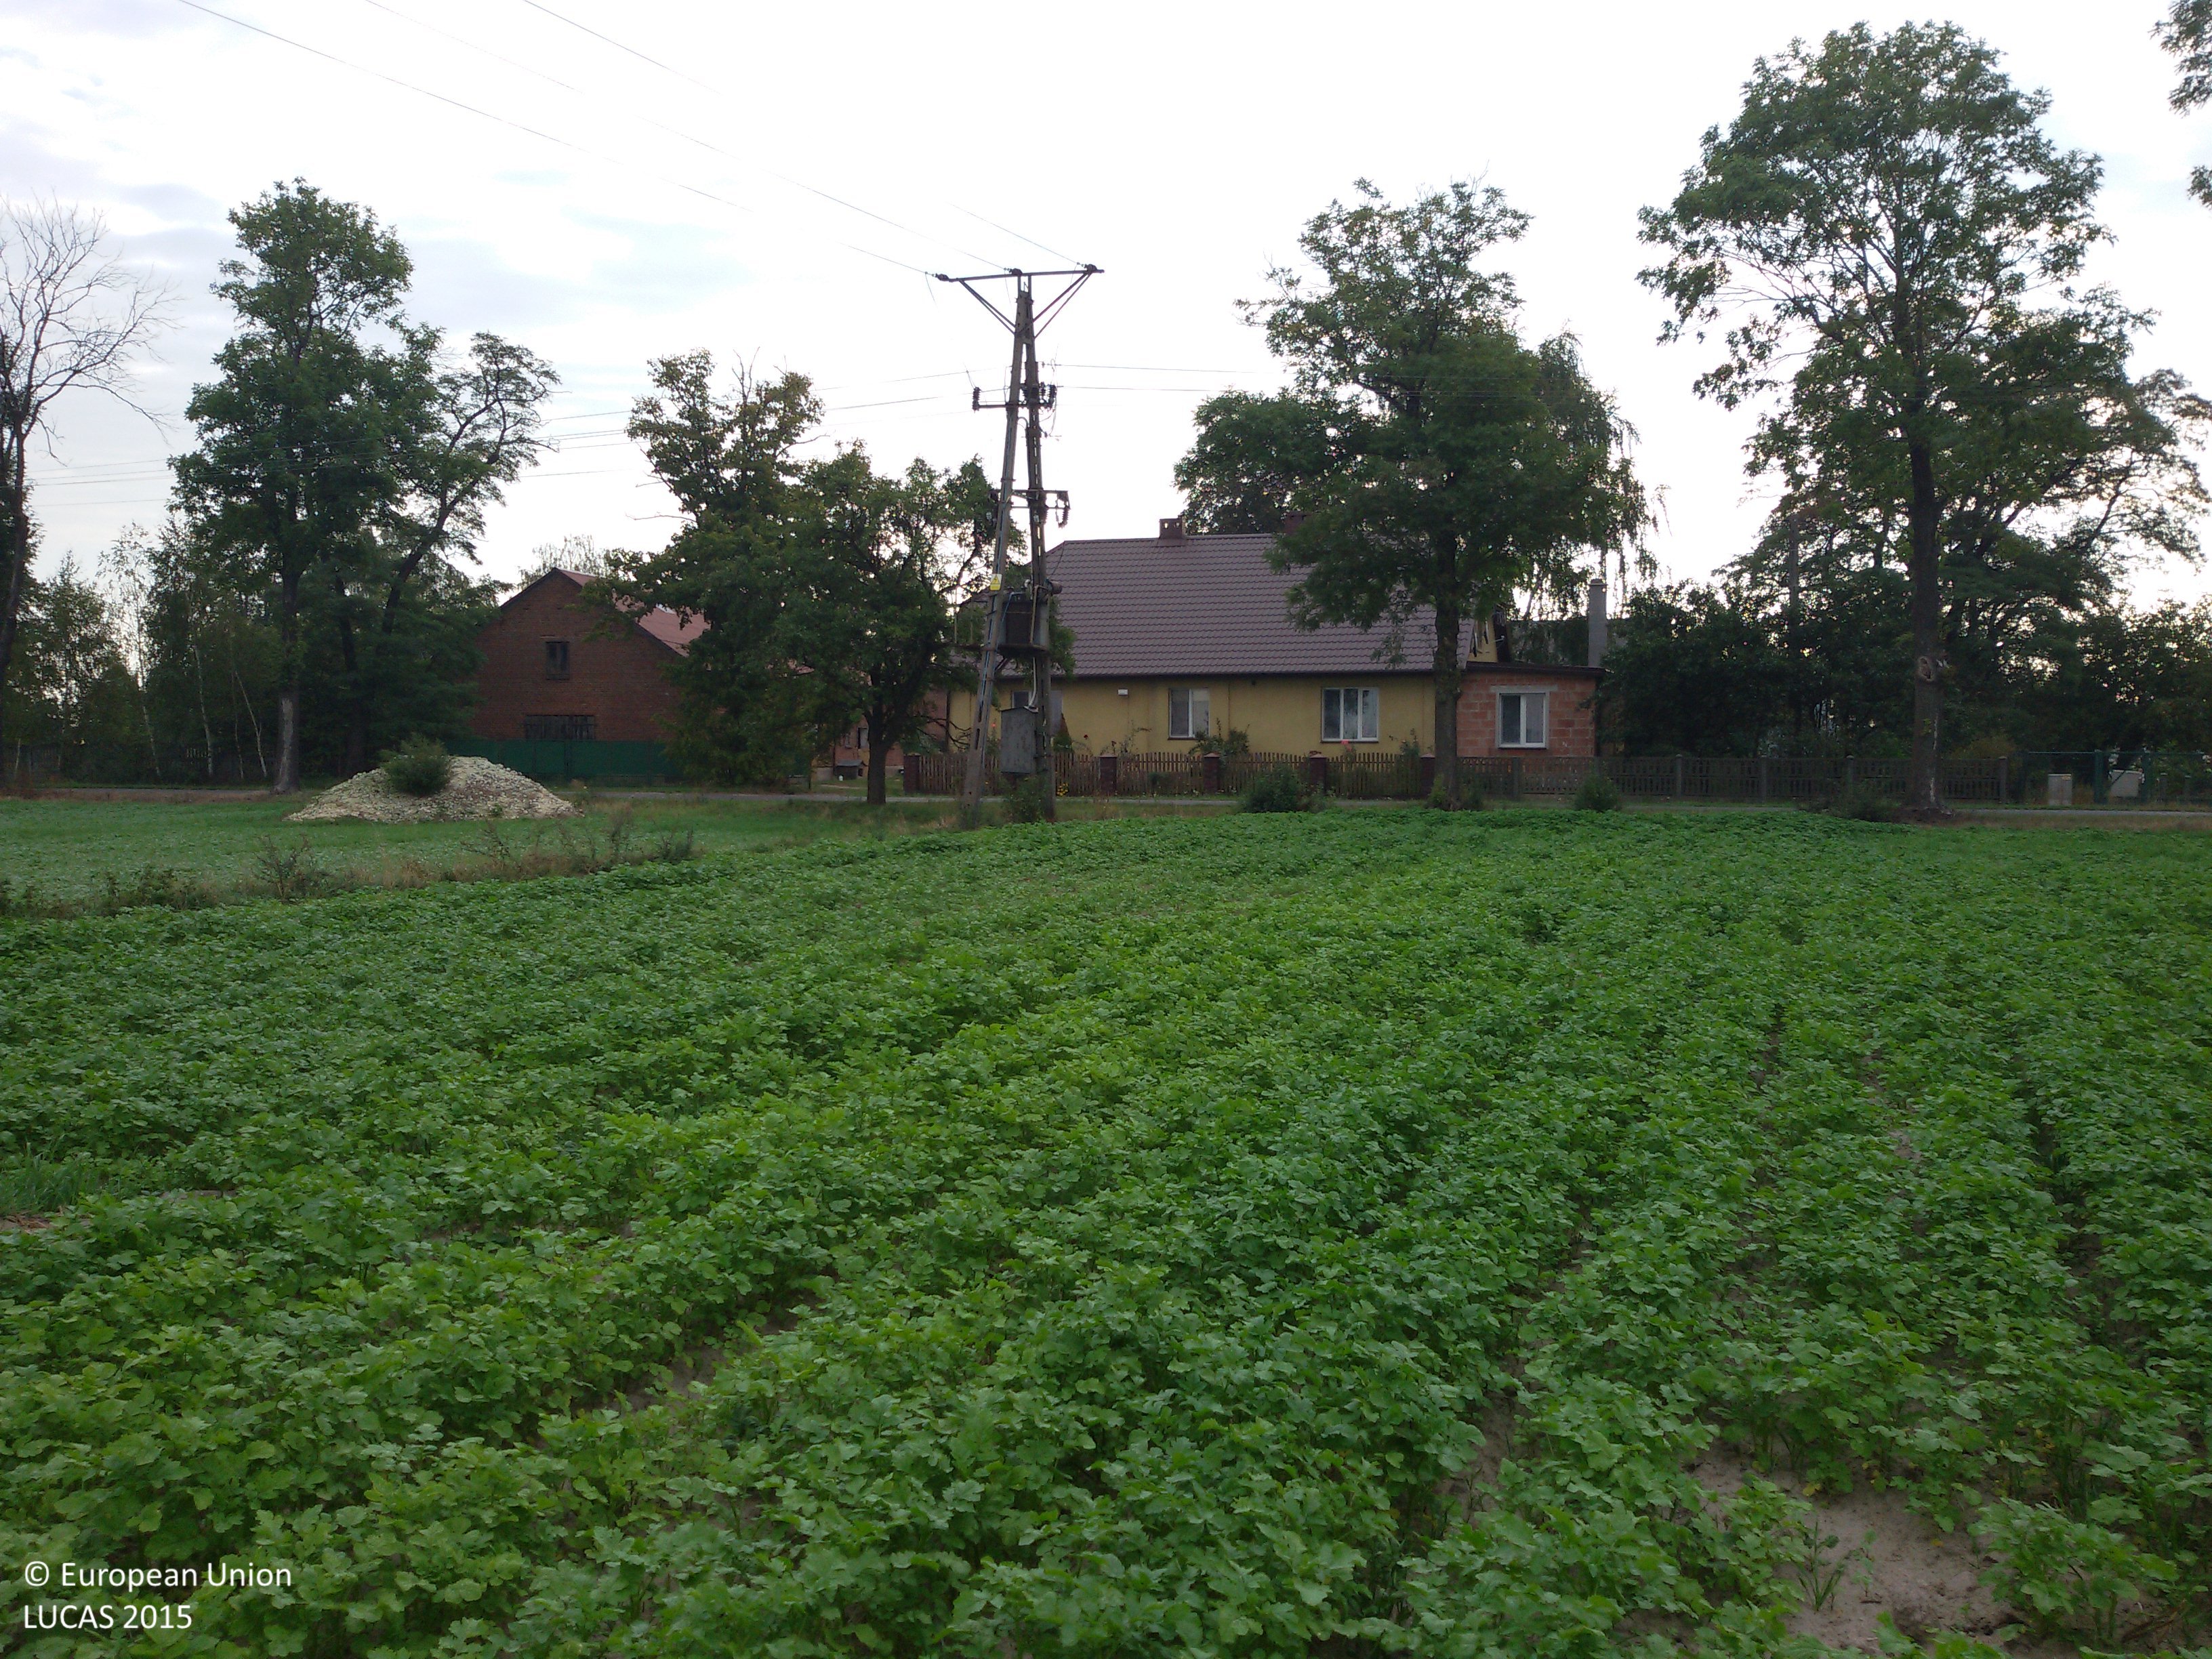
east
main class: Cropland
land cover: Rape and turnip rape
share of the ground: > 75 %
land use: Agriculture (excluding fallow land and kitchen gardens)
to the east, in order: Rape and turnip rape; Electric lines; Rape and turnip rape; Grass margins; Ditches and canals; Lines of trees; Paved roads, cycling and walking lanes; Ditches and canals; Artificial constructions in urban areas; Maize
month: September
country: PL
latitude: 52.2895
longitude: 17.9763
